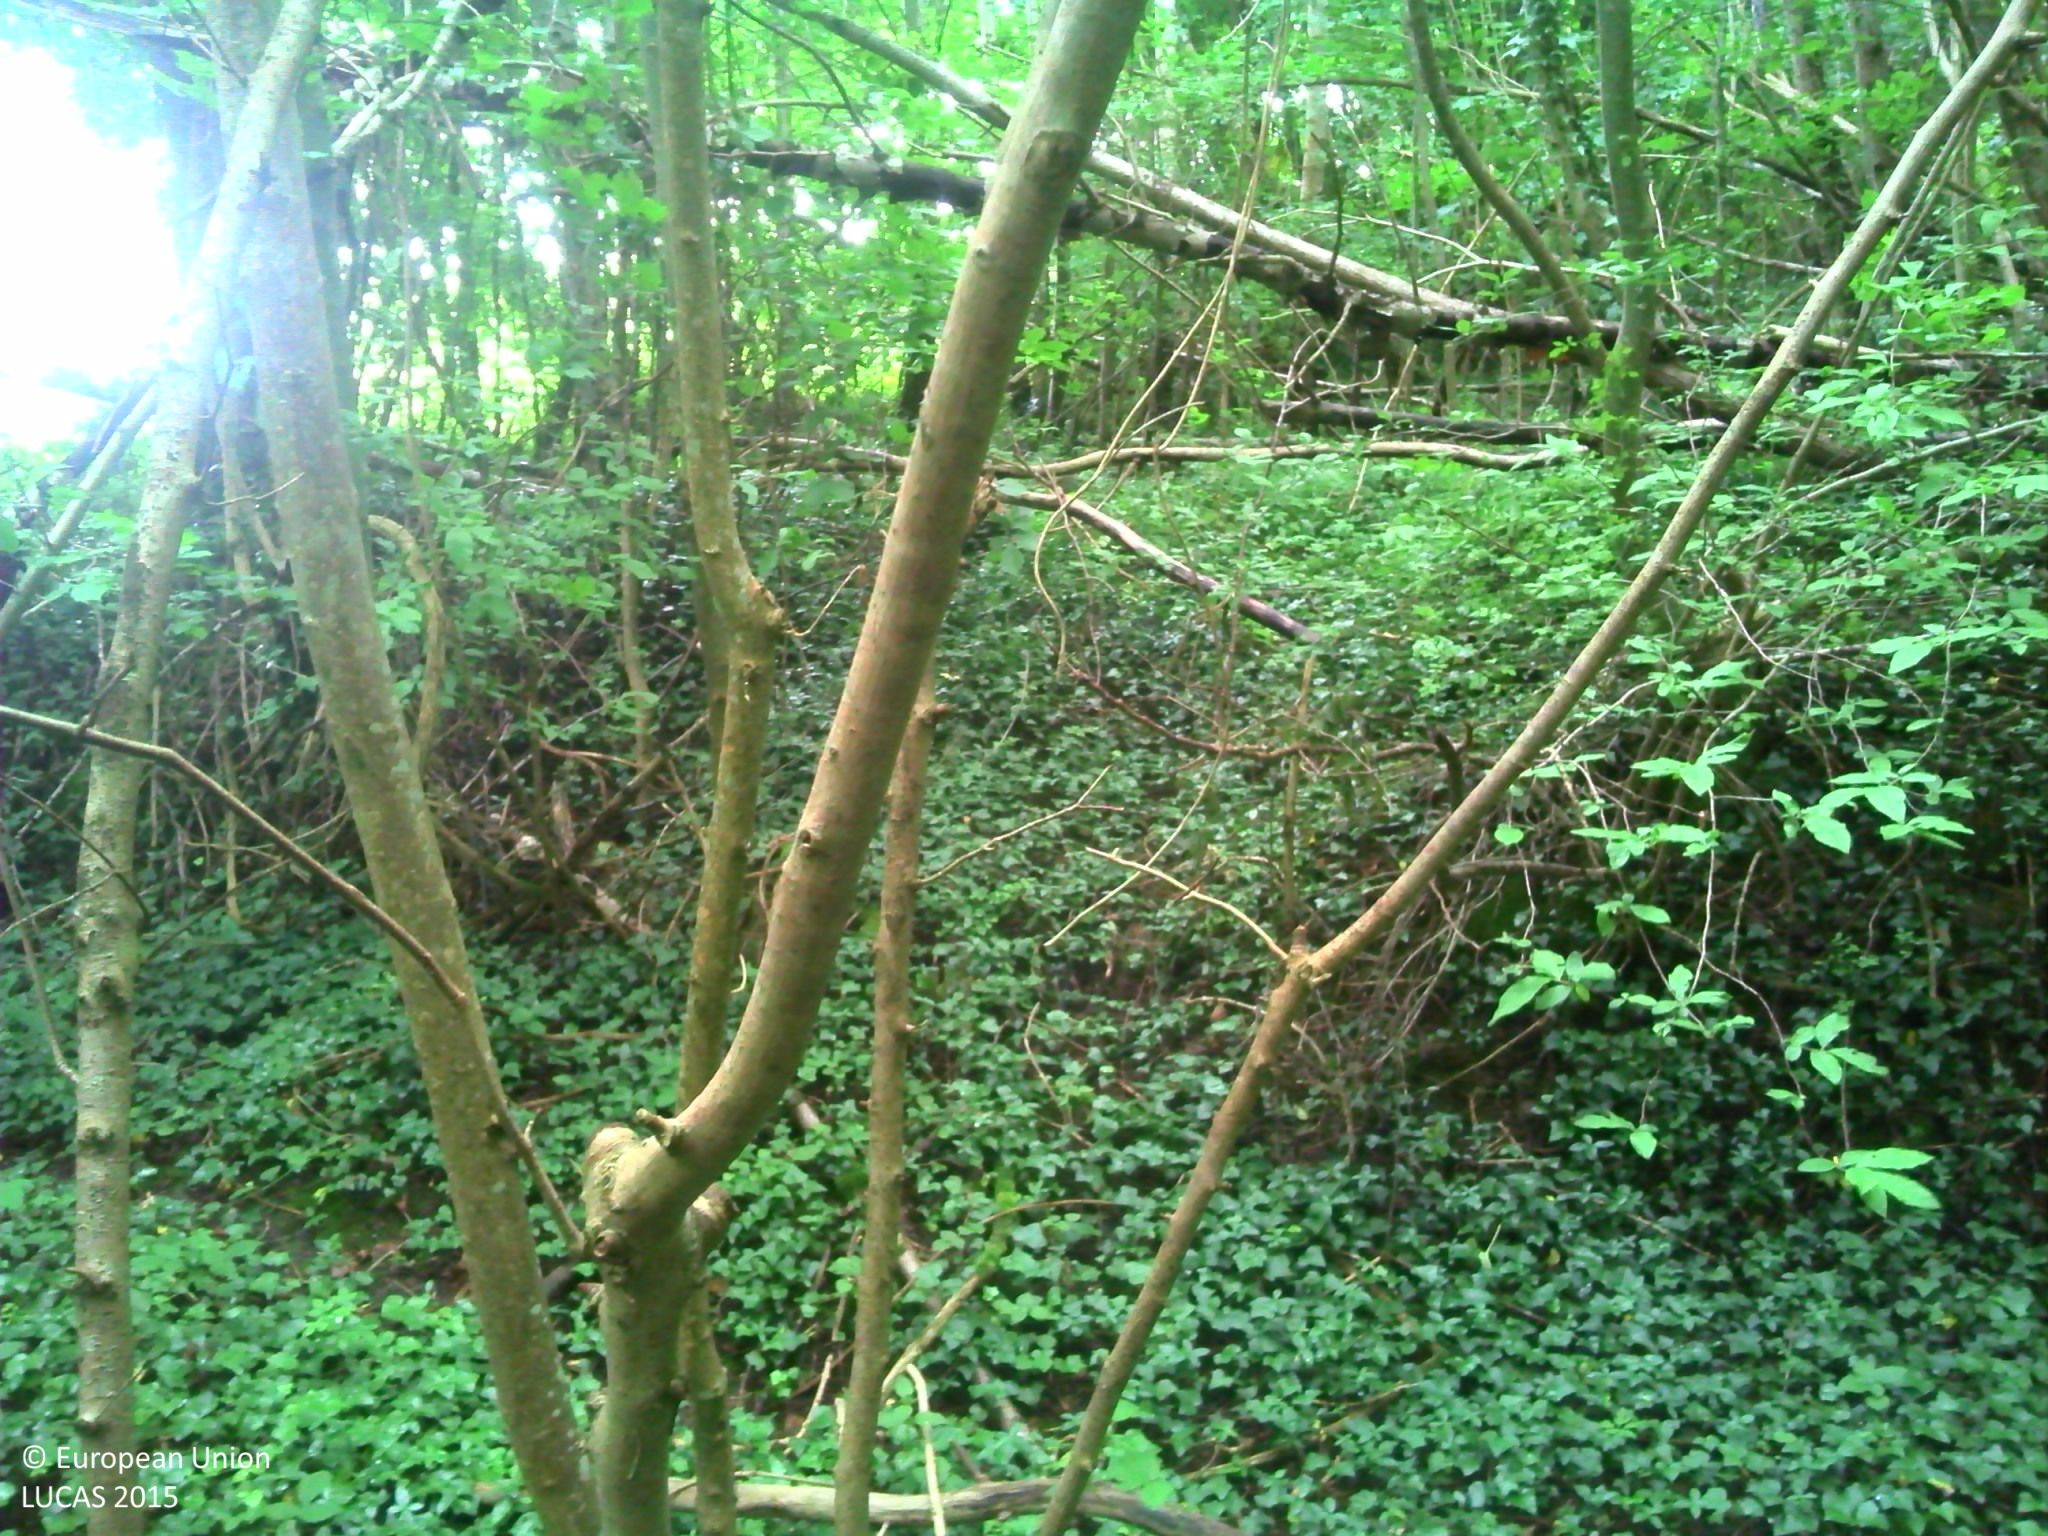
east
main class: Woodland
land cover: Broadleaved woodland
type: mesophytic deciduous forest
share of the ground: > 75 %
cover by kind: broadleaved forest trees 85 %, shrubs 10 %, herbaceous plants 5 %
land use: Forestry
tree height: > 5 m
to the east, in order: Broadleaved woodland; Rape and turnip rape
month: June
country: FR
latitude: 49.5040
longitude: 3.6828
